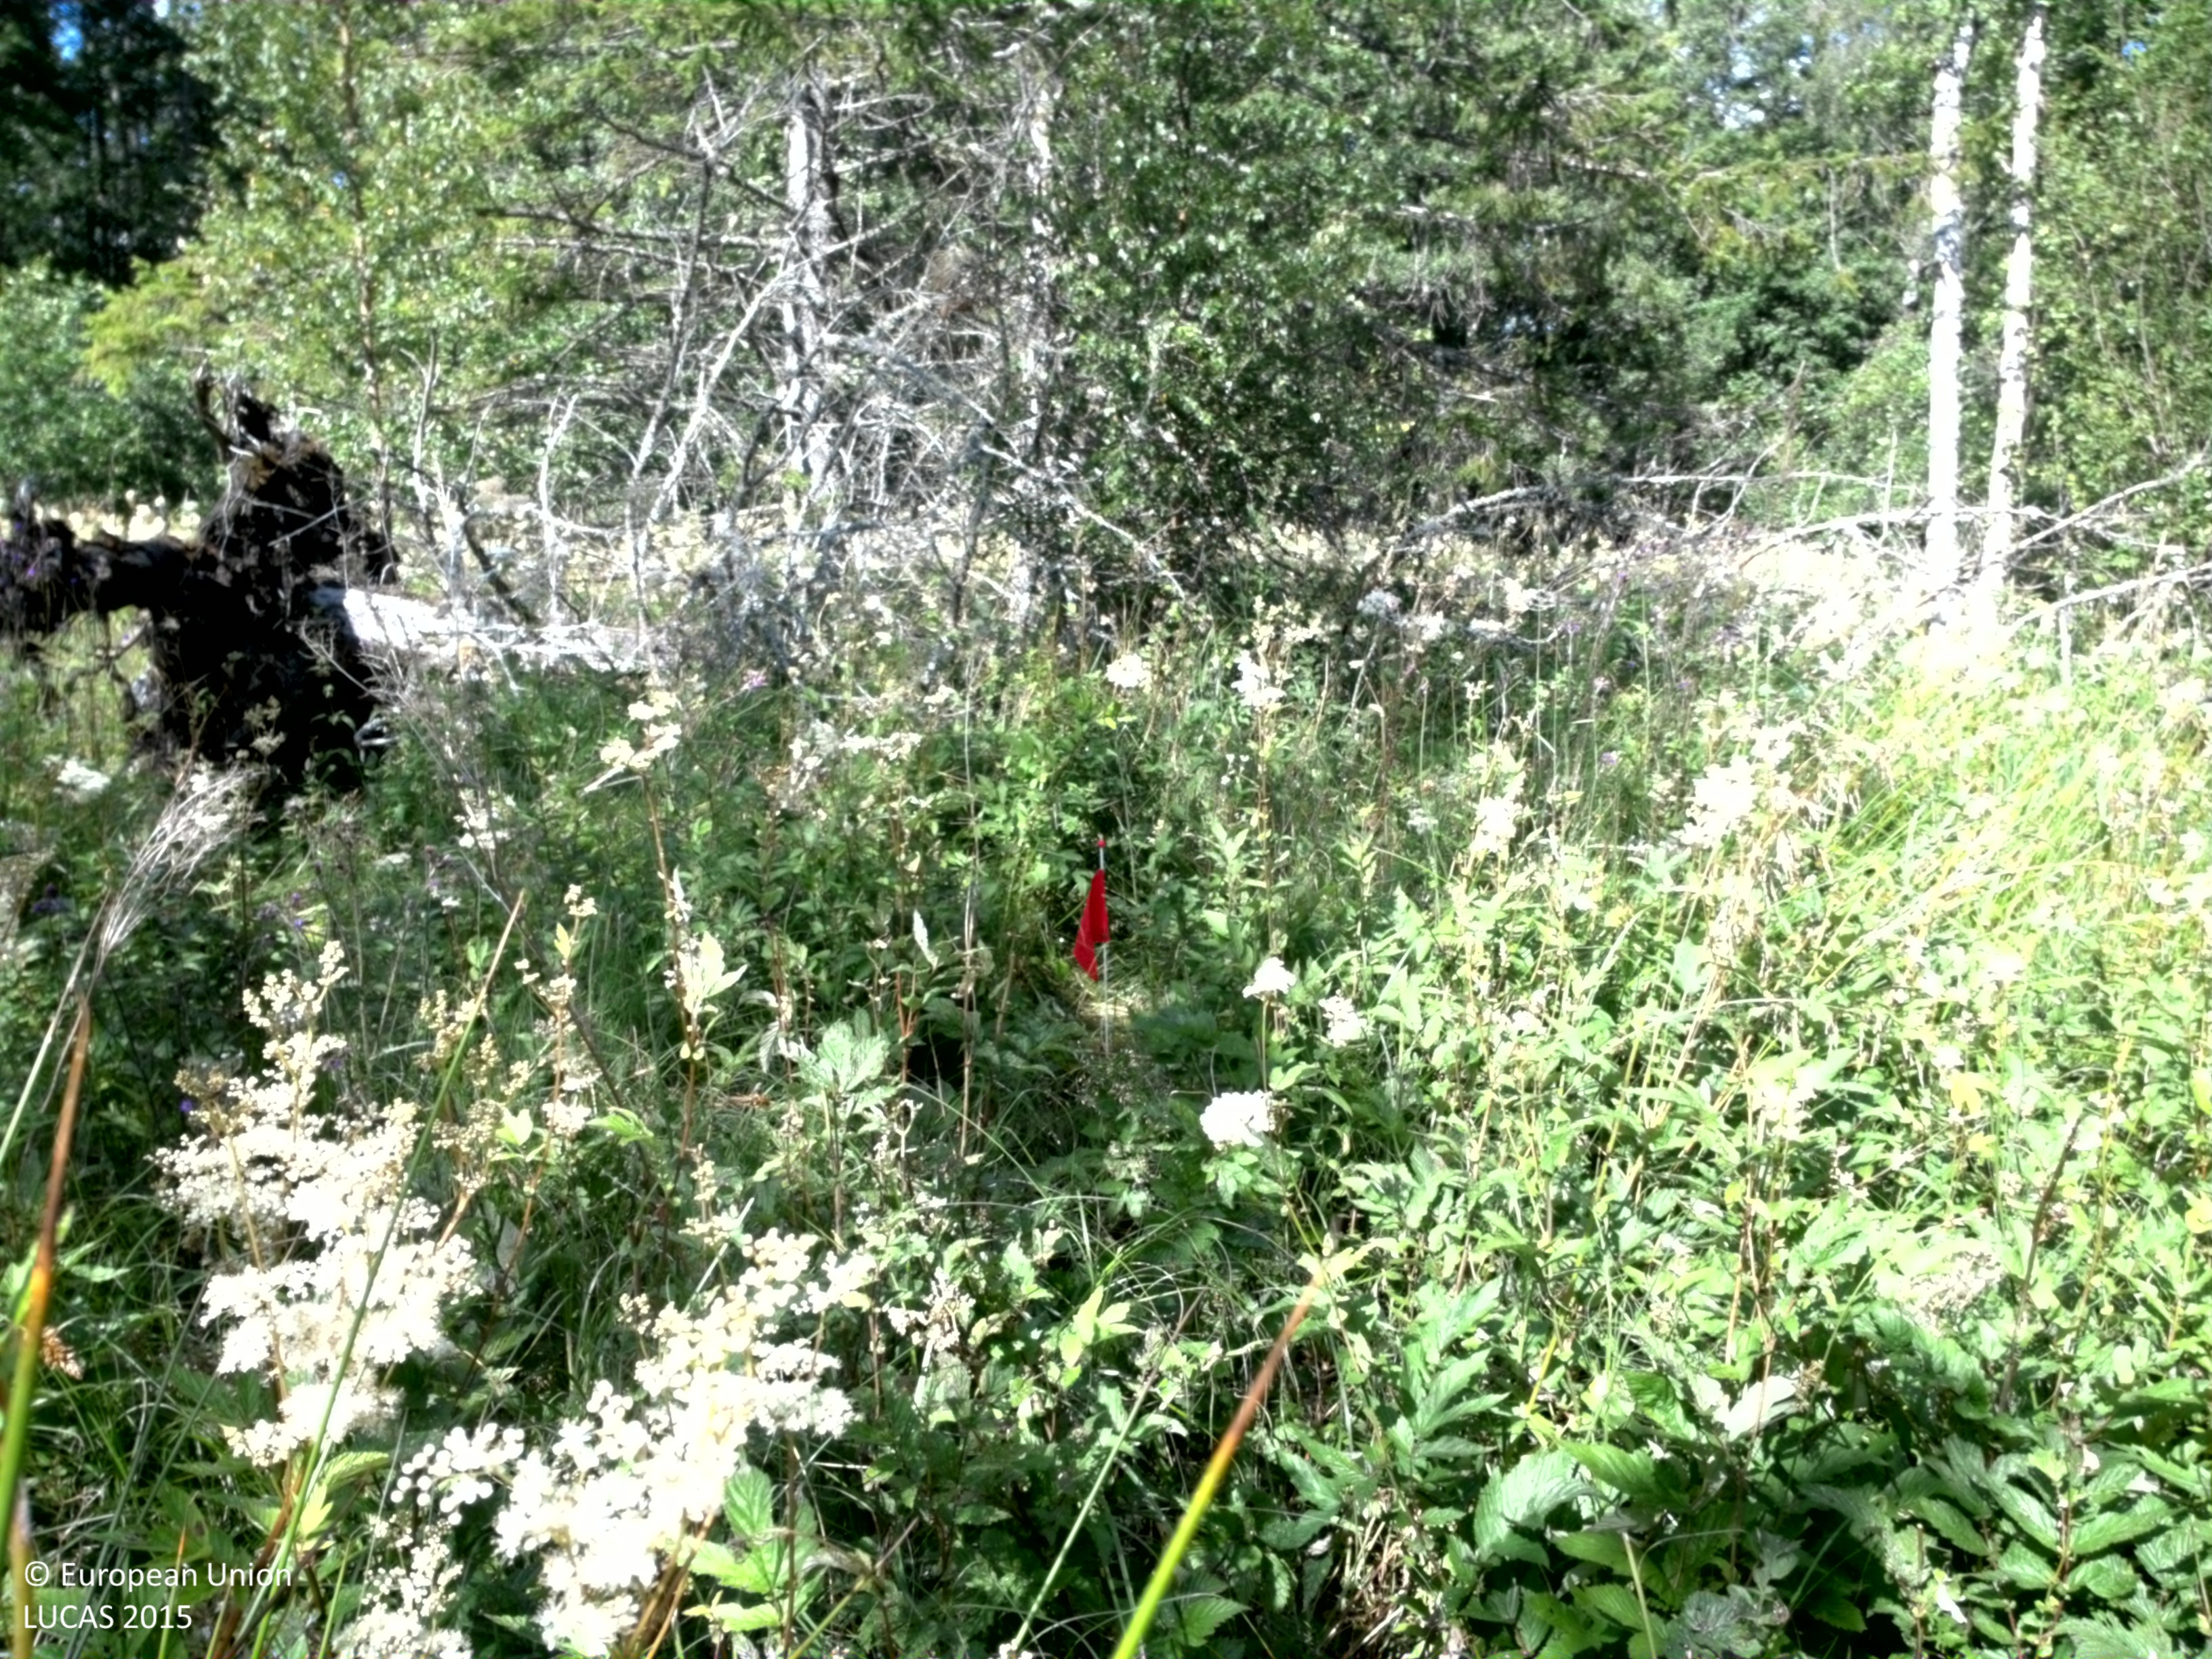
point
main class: Woodland
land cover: Spruce dominated mixed woodland
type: boreal forest
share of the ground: 25 - 50 %
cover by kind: herbaceous plants 70 %, coniferous forest trees 15 %, broadleaved forest trees 15 %
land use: Agriculture (excluding fallow land and kitchen gardens)
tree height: > 5 m
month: August
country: SE
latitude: 58.1085
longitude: 13.9146
